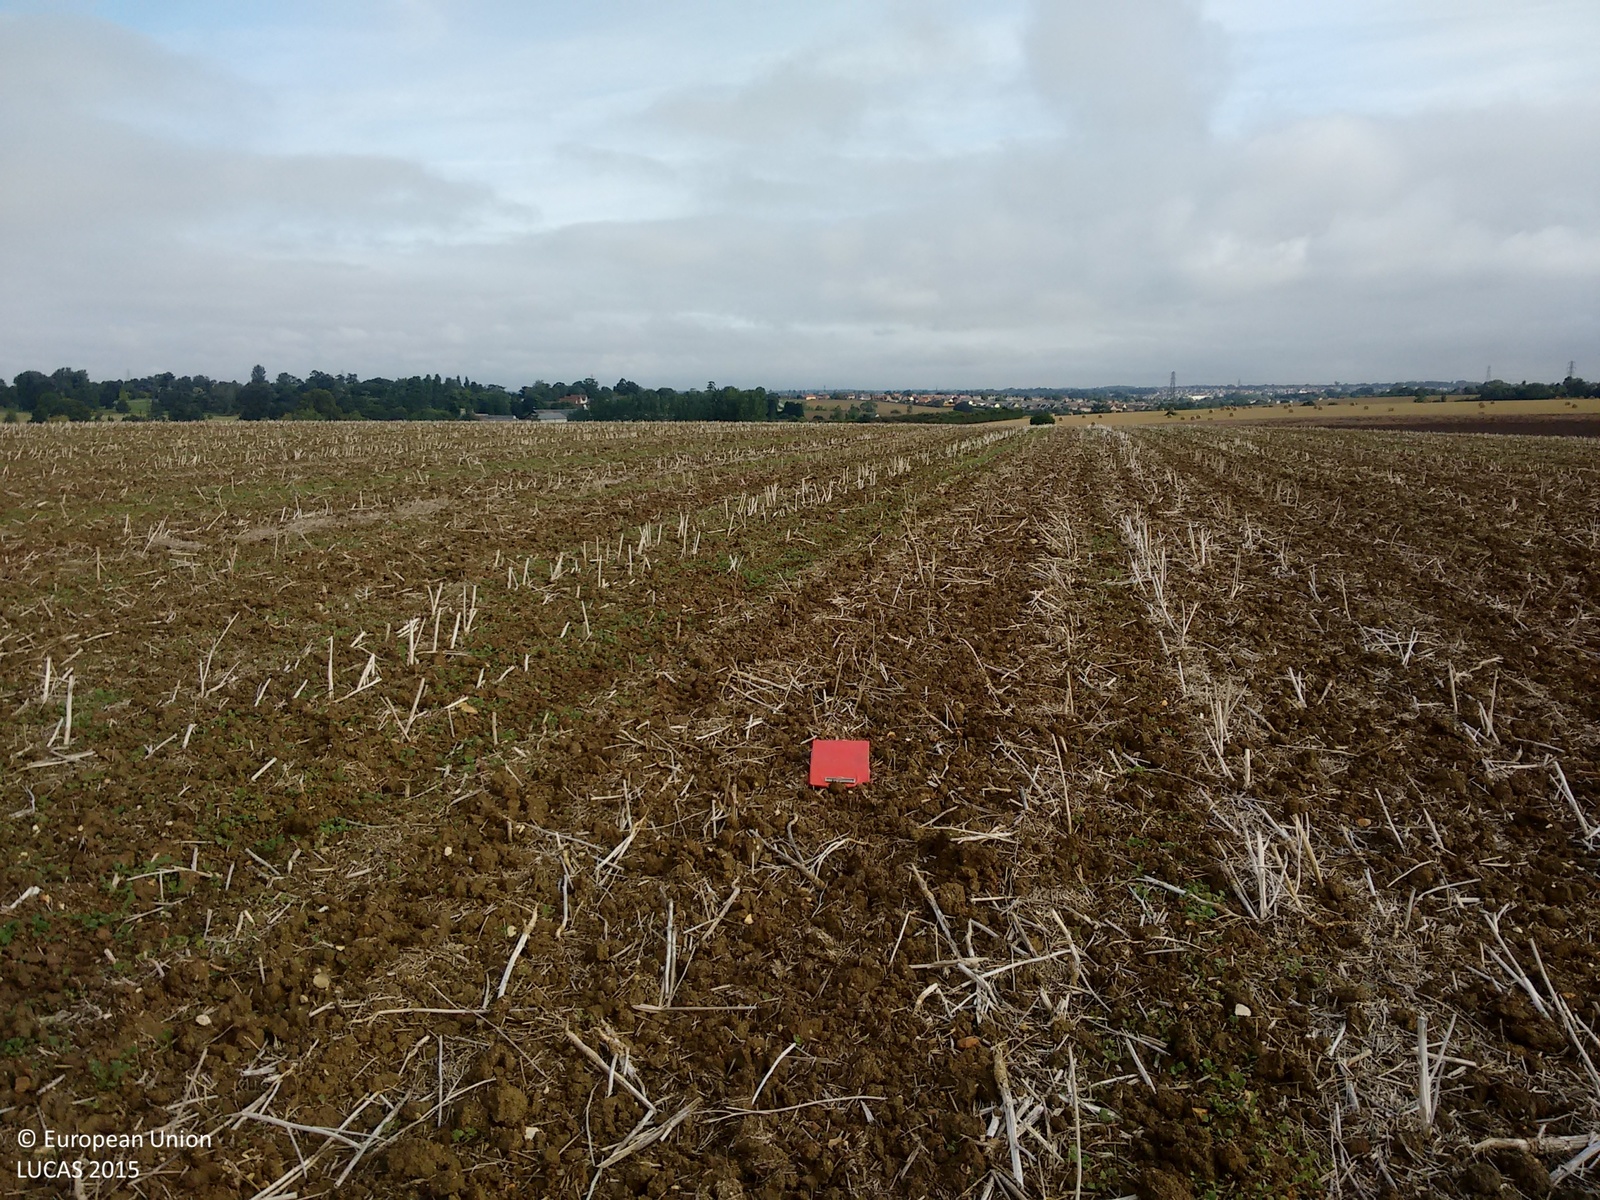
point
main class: Cropland
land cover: Rape and turnip rape
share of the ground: 25 - 50 %
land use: Agriculture (excluding fallow land and kitchen gardens)
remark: Harvested field
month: September
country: GB
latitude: 52.1607
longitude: 0.9864
